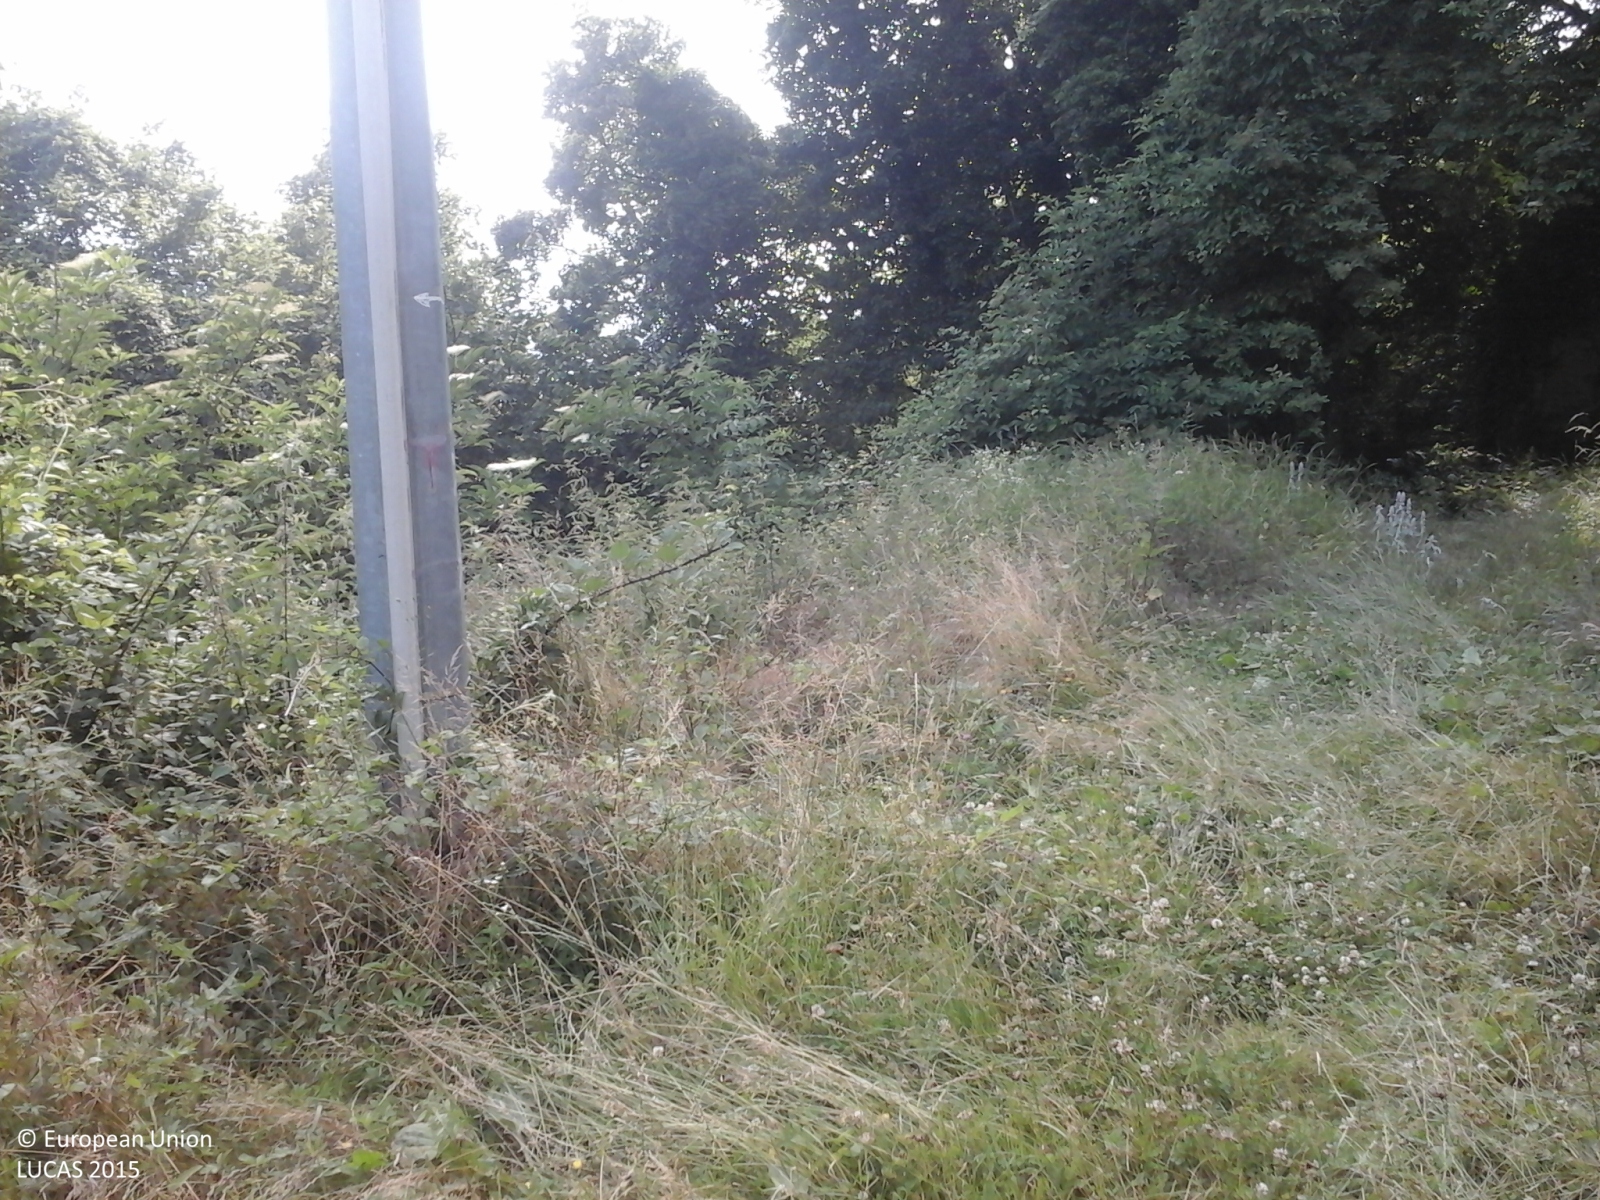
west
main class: Woodland
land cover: Broadleaved woodland
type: mesophytic deciduous forest
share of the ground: > 75 %
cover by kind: broadleaved forest trees 100 %
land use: Forestry
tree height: > 5 m
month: June
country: IT
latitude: 45.1605
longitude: 7.1931
